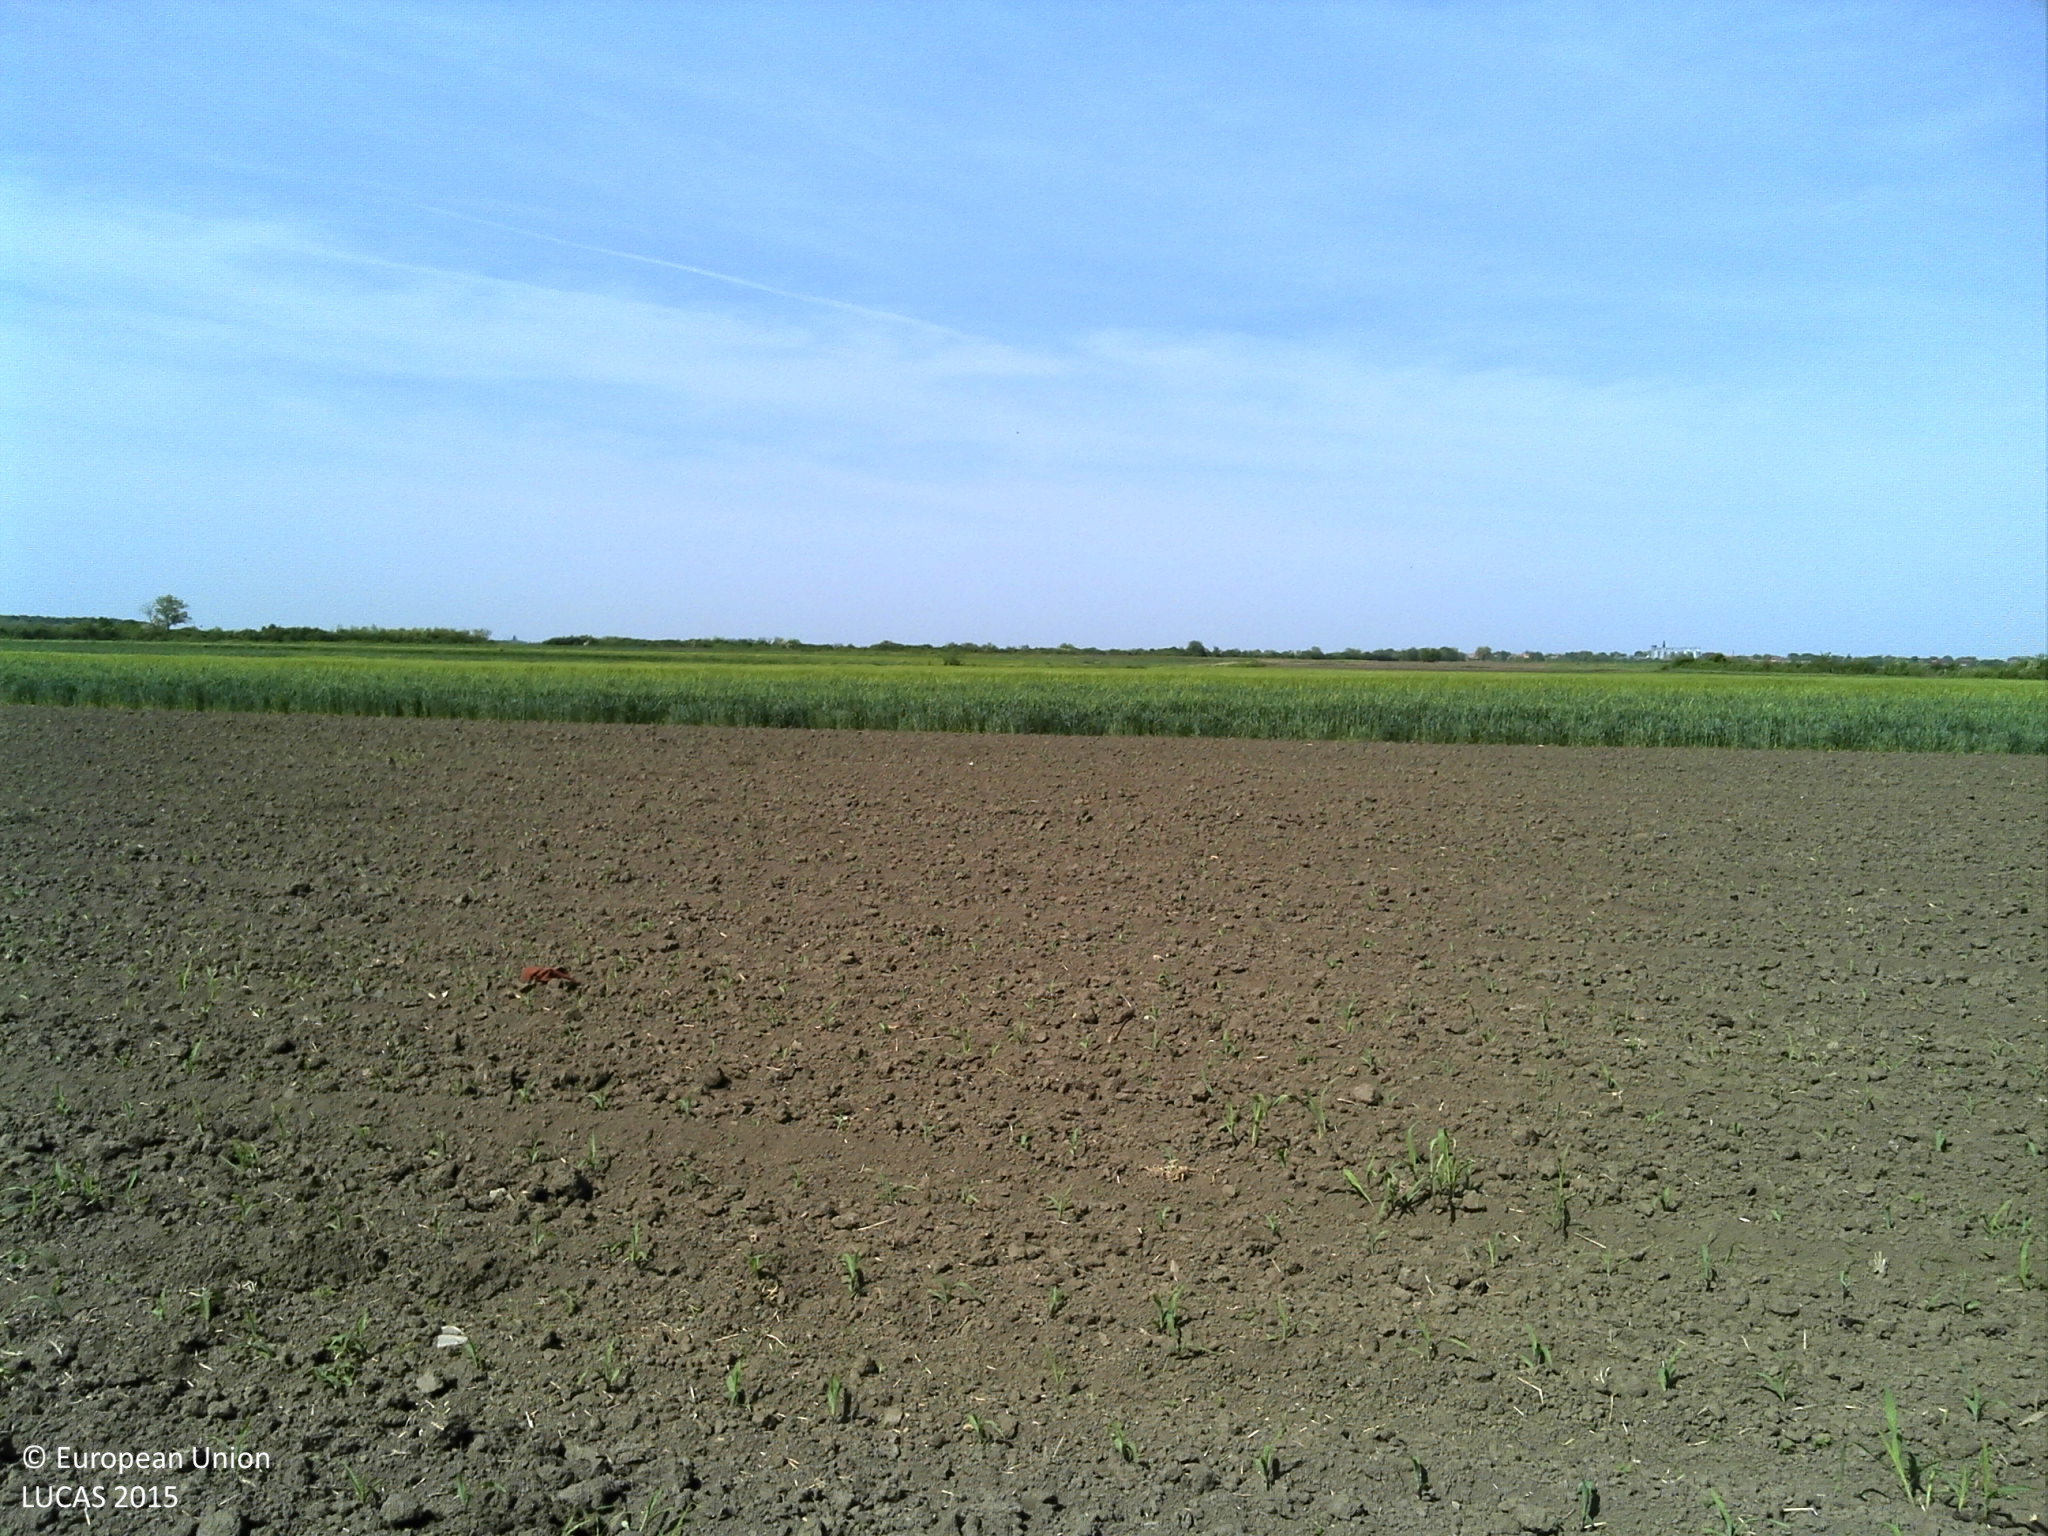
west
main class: Cropland
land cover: Maize
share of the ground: < 10 %
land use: Agriculture (excluding fallow land and kitchen gardens)
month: May
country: HR
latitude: 45.4187
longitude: 18.8900
